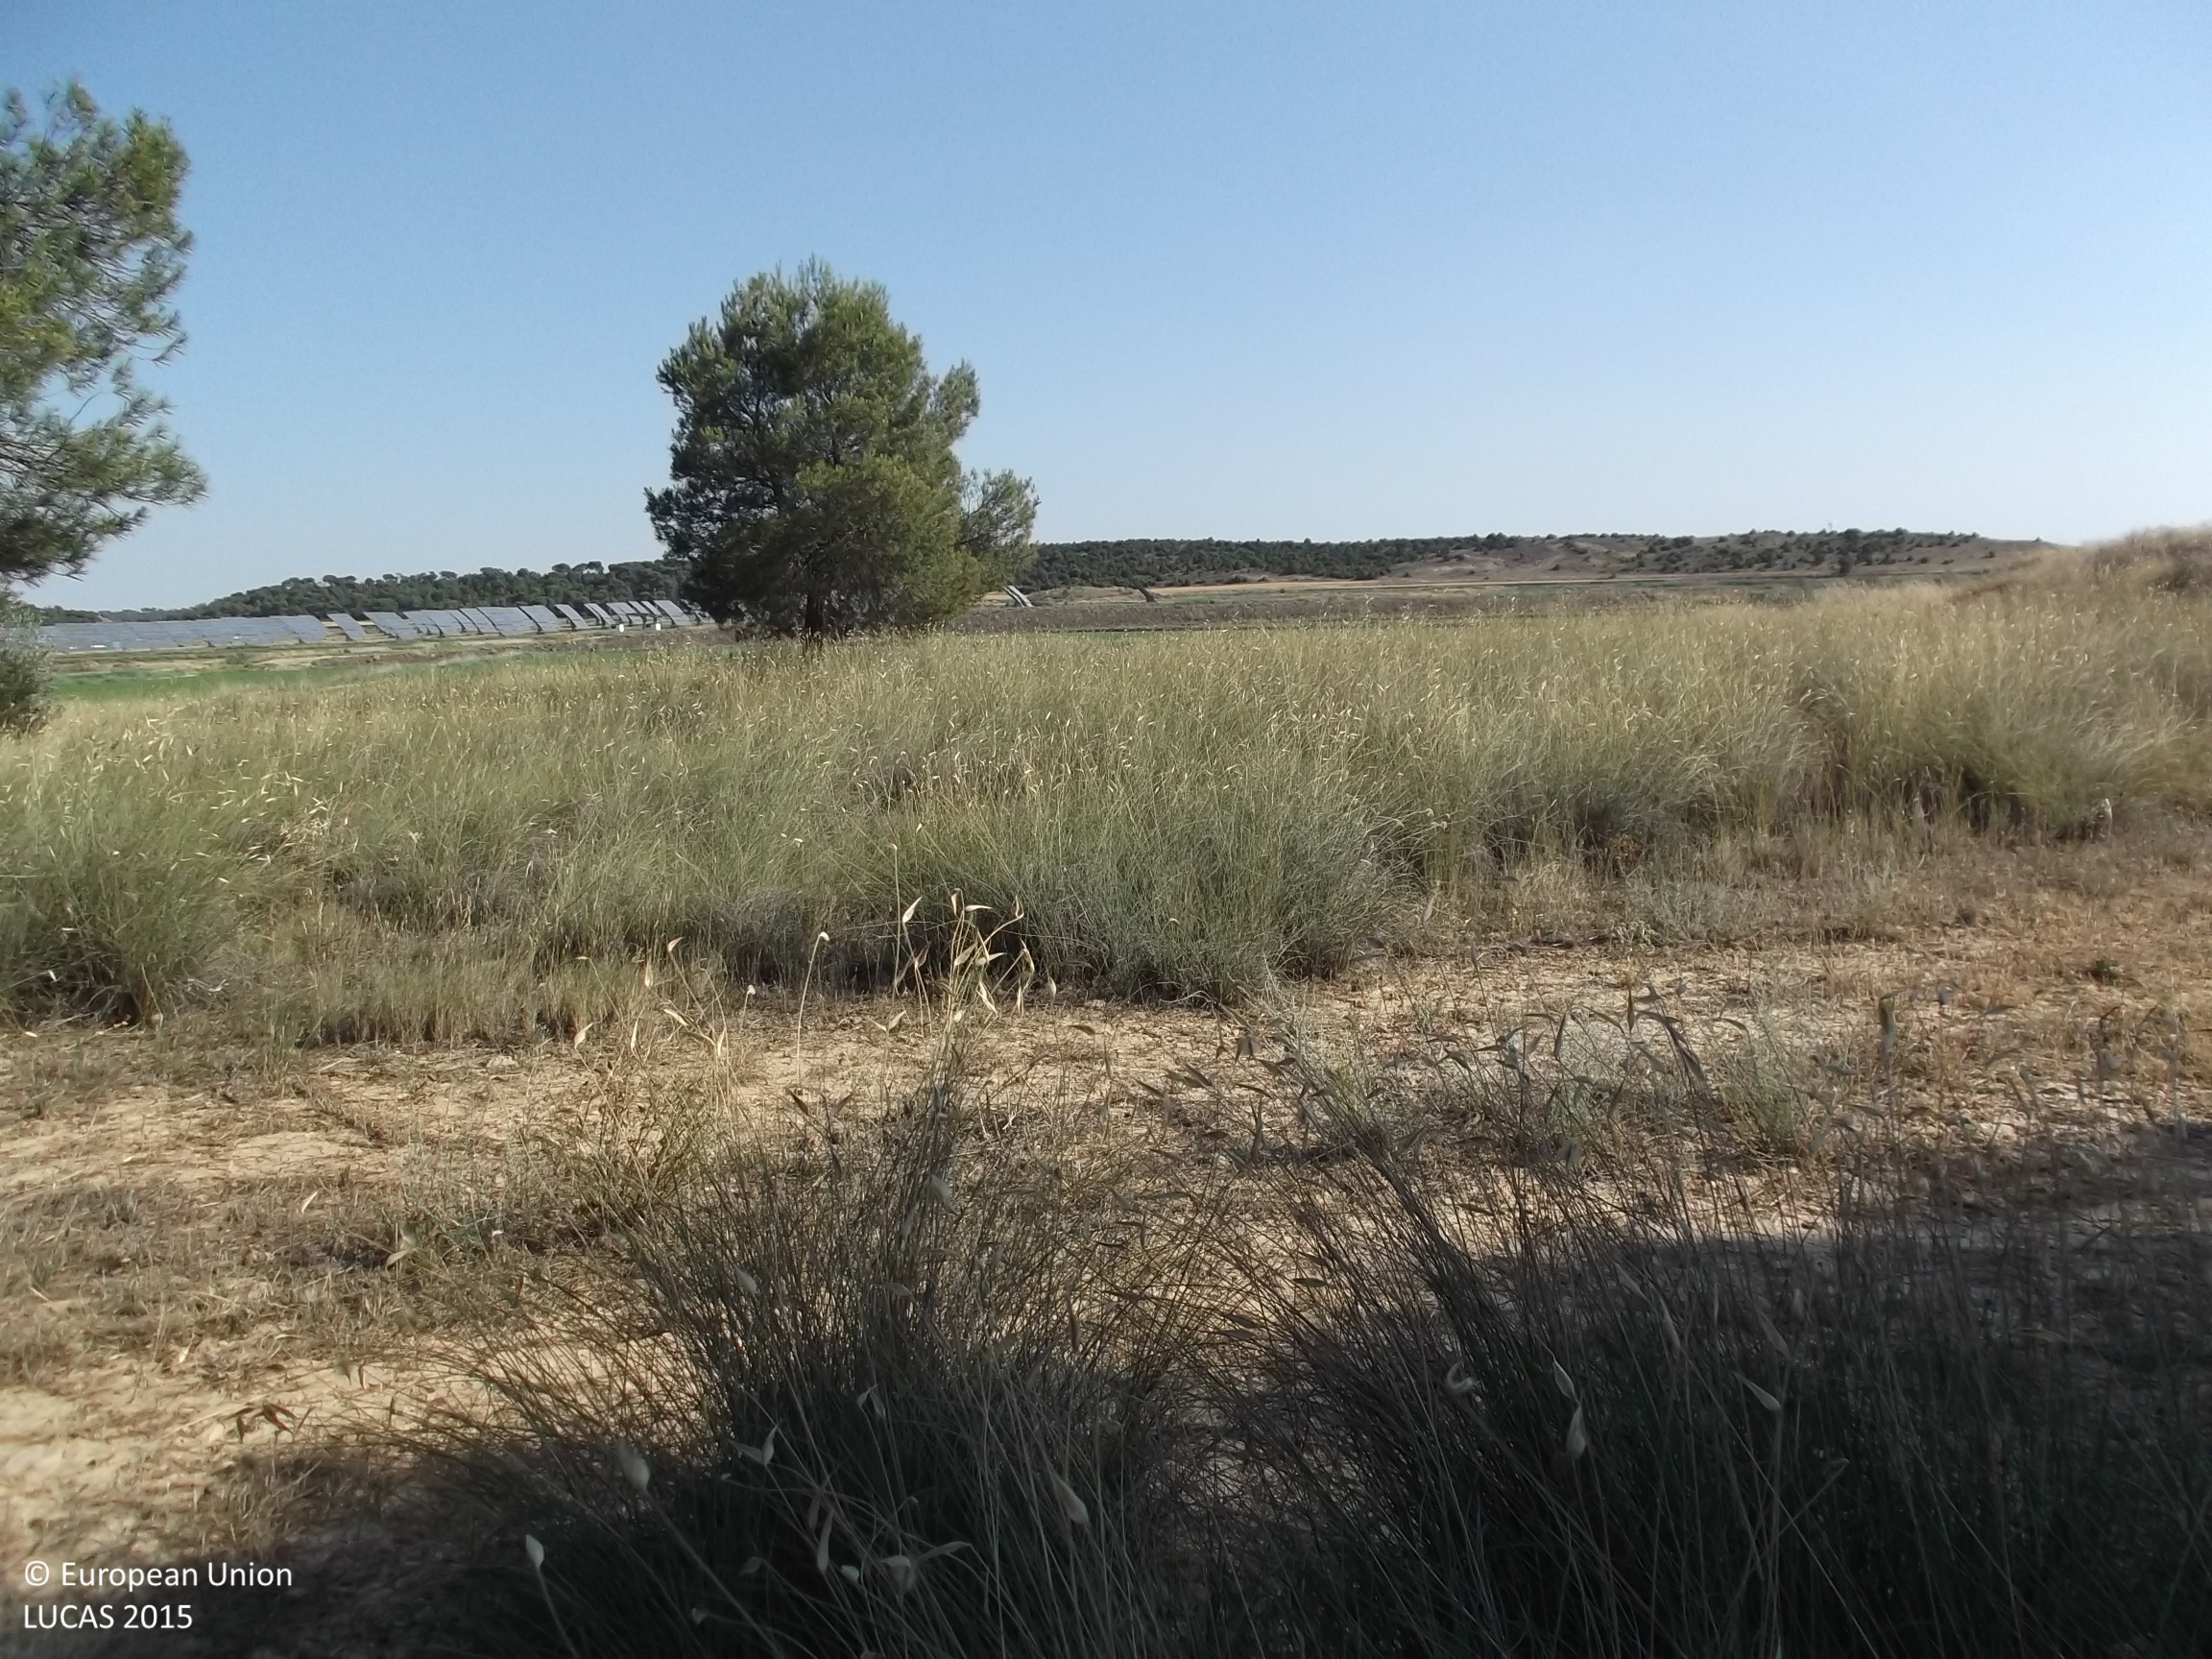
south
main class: Woodland
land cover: Pine dominated coniferous woodland
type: coniferous forest of the mediterranean region
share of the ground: 50 - 75 %
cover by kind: coniferous forest trees 70 %, herbaceous plants 20 %, unconsolidated bare surface 10 %
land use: Semi-natural and natural areas not in use
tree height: < 5 m
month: July
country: ES
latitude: 42.3315
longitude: -1.5999
